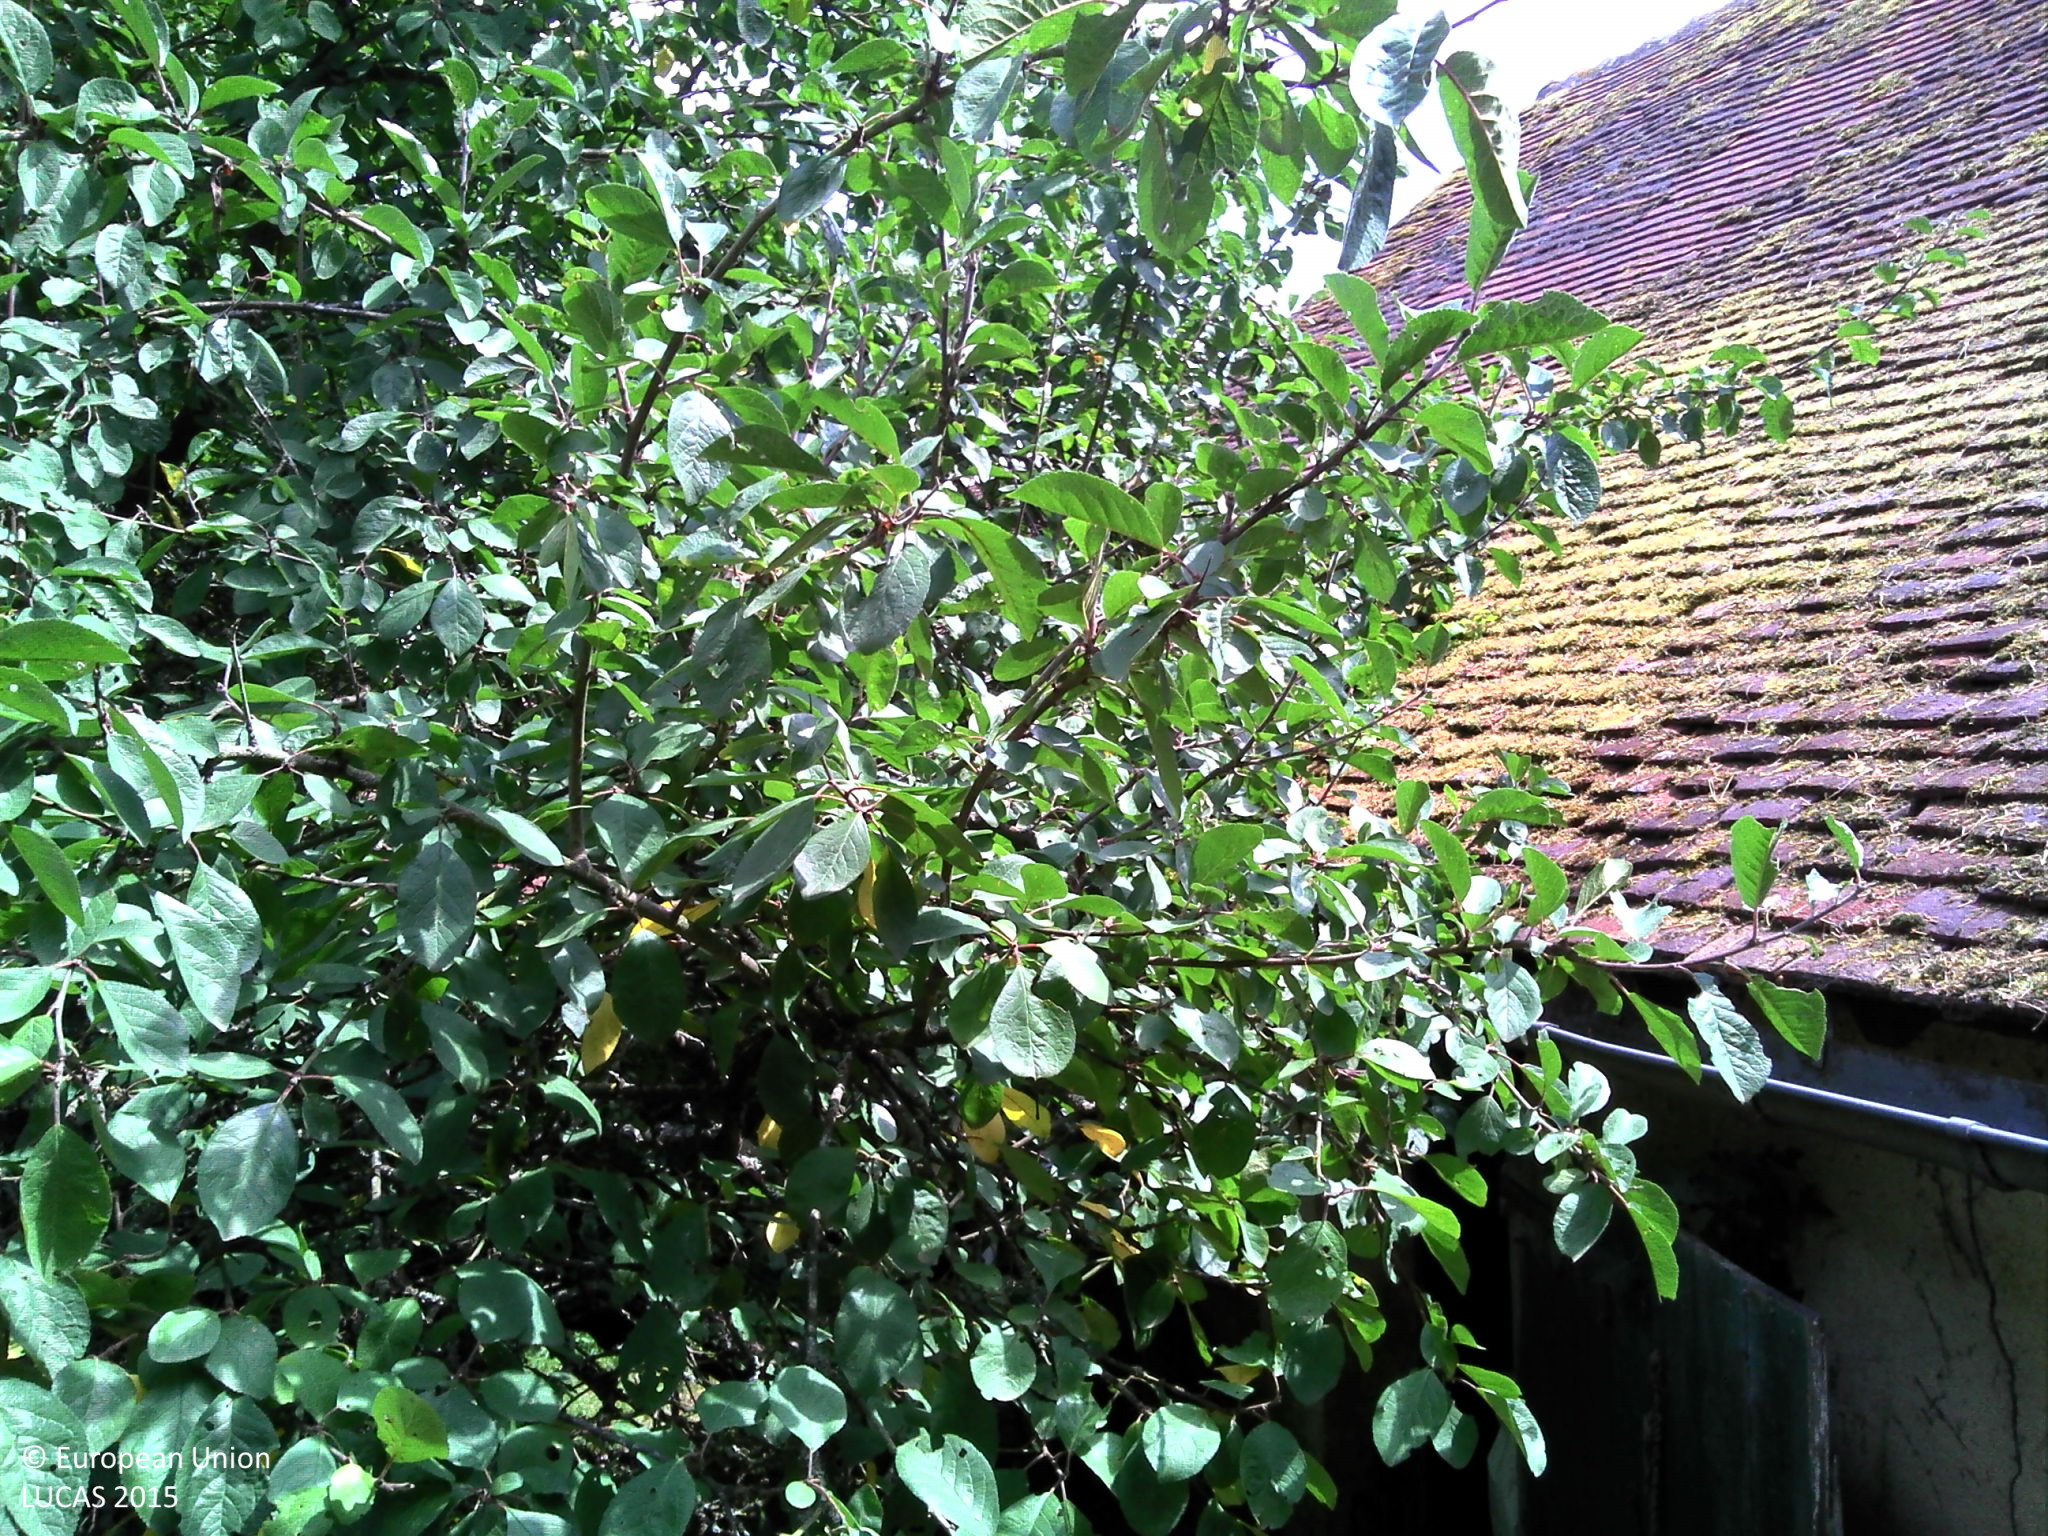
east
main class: Grassland
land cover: Grassland with sparse tree/shrub cover
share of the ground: > 75 %
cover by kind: herbaceous plants 90 %, broadleaved forest trees 5 %, shrubs 5 %
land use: Amenities, museums, leisure
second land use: Residential
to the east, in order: Grassland with sparse tree/shrub cover; Artificial constructions in urban areas; Grassland with sparse tree/shrub cover; Abandoned hedges; Fences; Grassland without tree/shrub cover; Fences; Broadleaved woodland
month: July
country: FR
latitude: 47.8617
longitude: 3.0829
